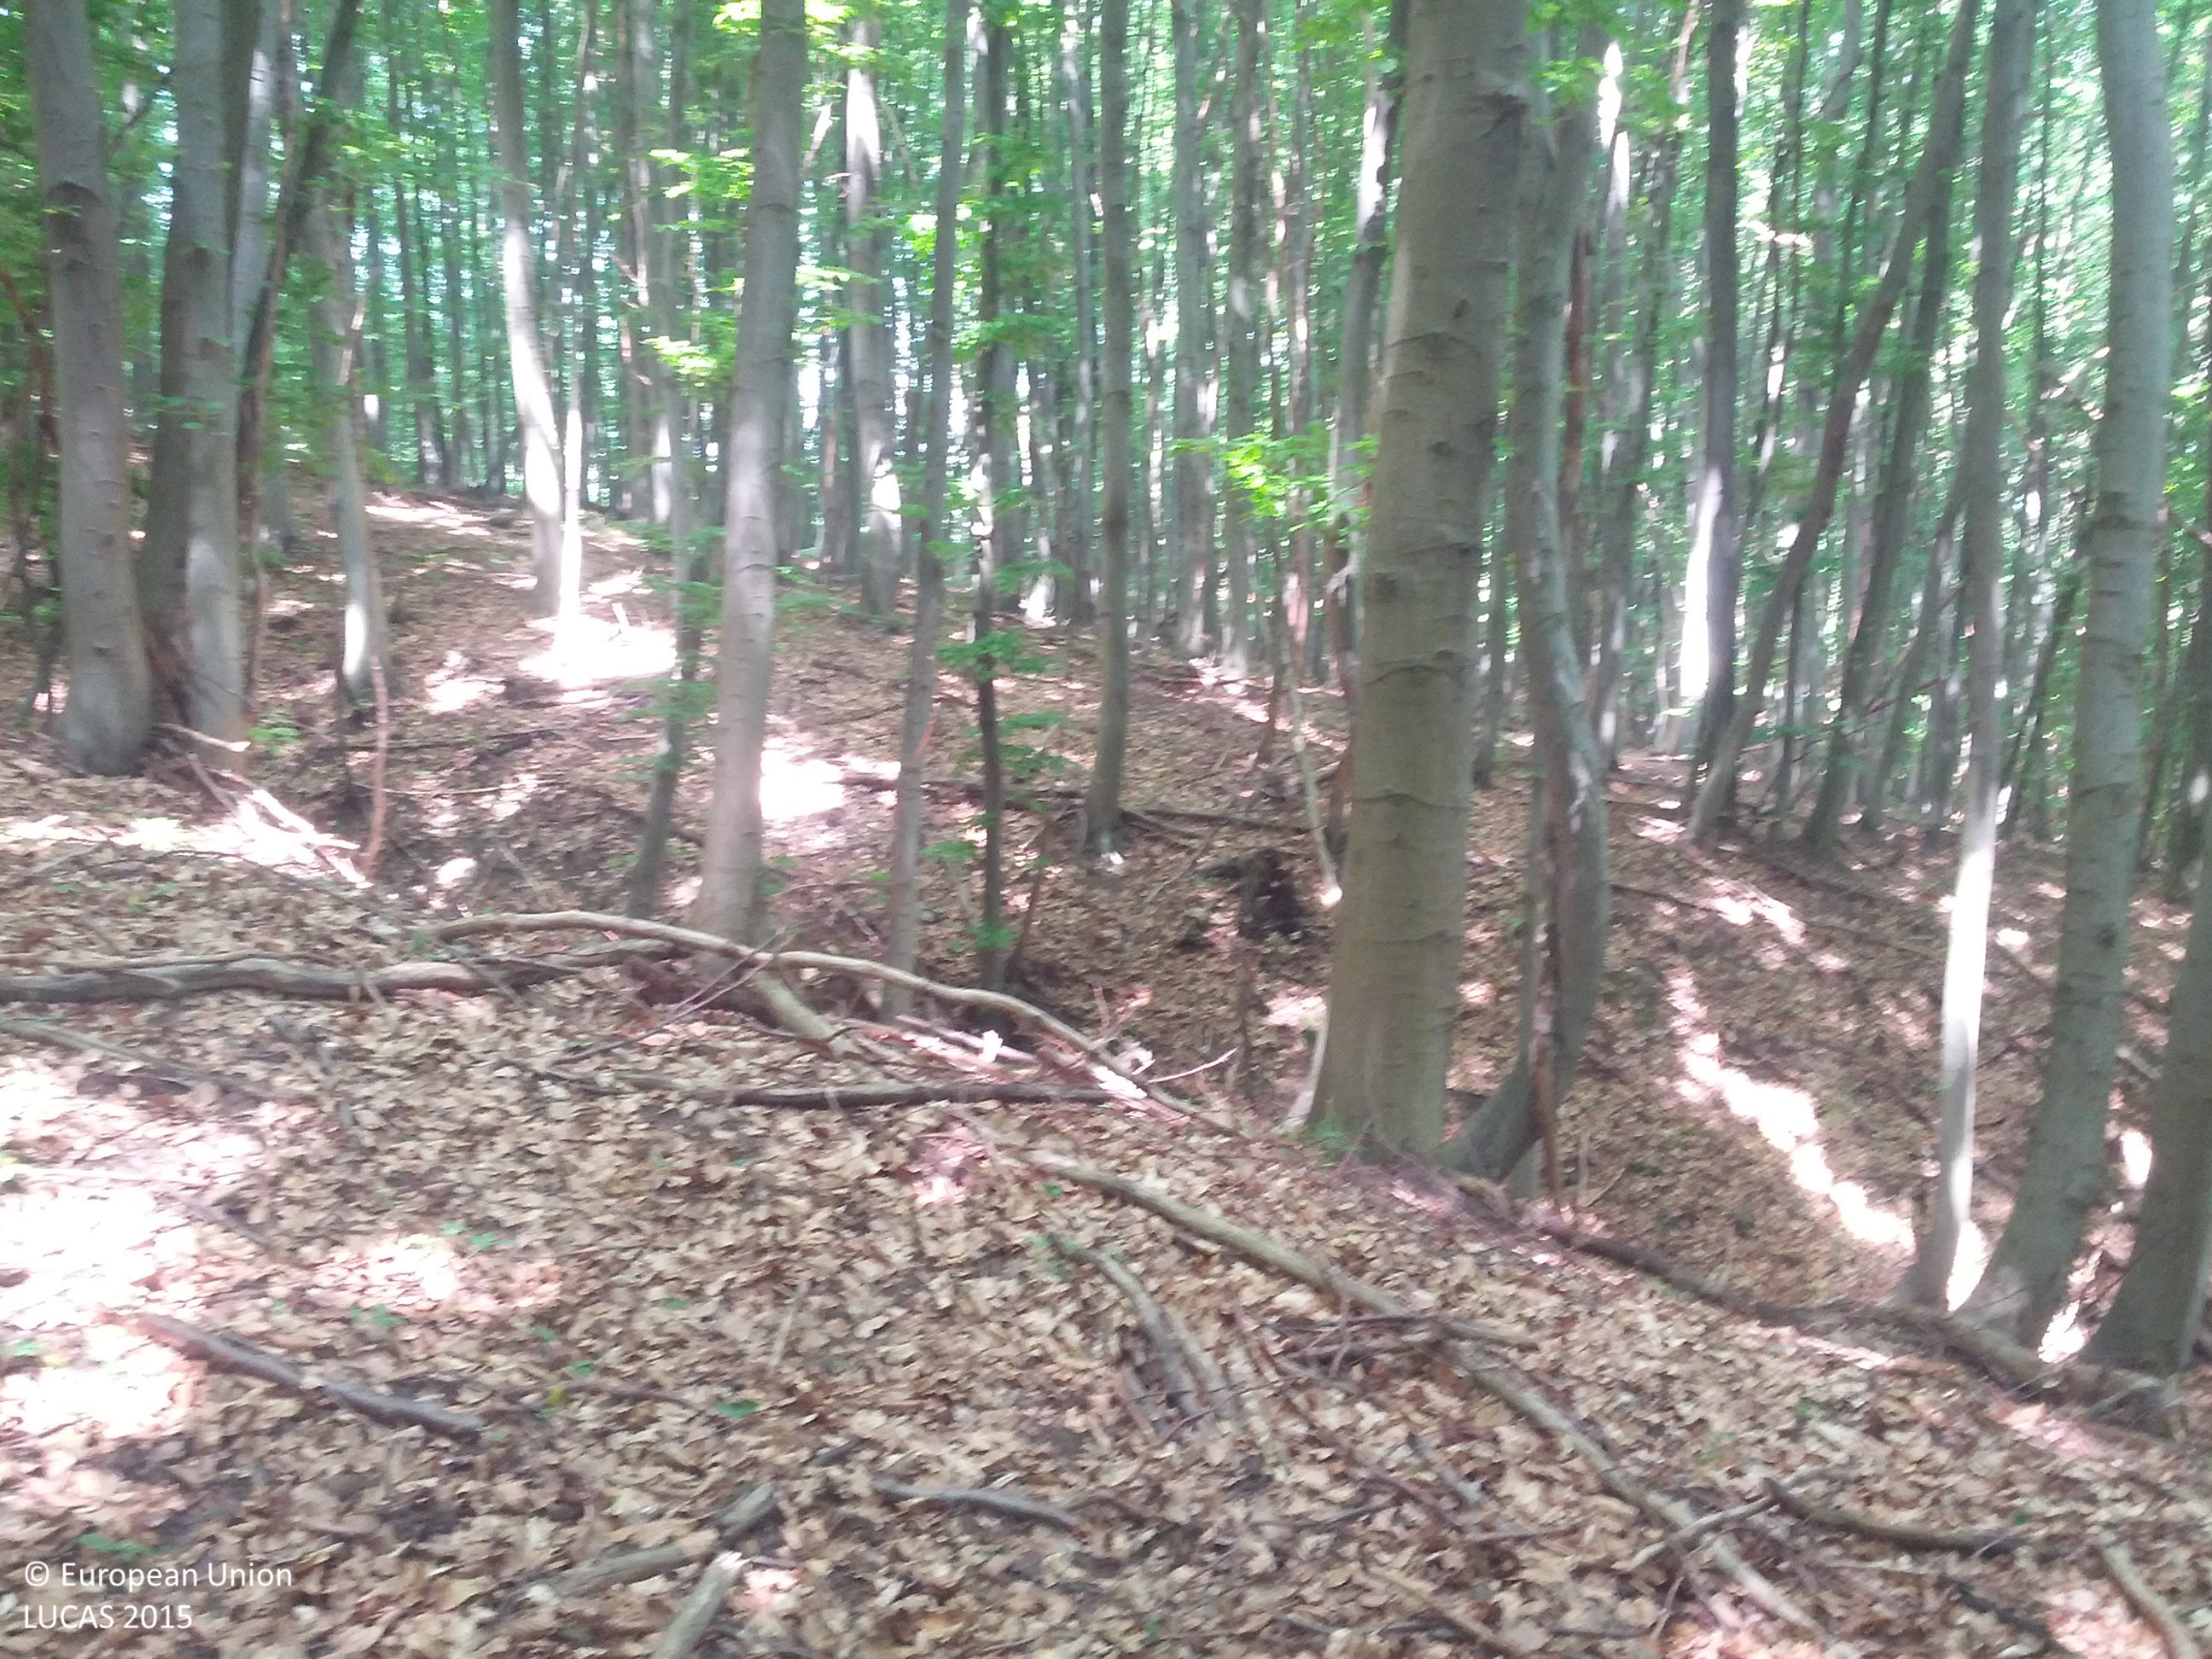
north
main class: Woodland
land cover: Broadleaved woodland
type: beech forest
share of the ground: > 75 %
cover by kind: broadleaved forest trees 95 %, herbaceous plants 5 %
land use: Forestry
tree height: > 5 m
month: May
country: AT
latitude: 48.2140
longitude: 16.1547
